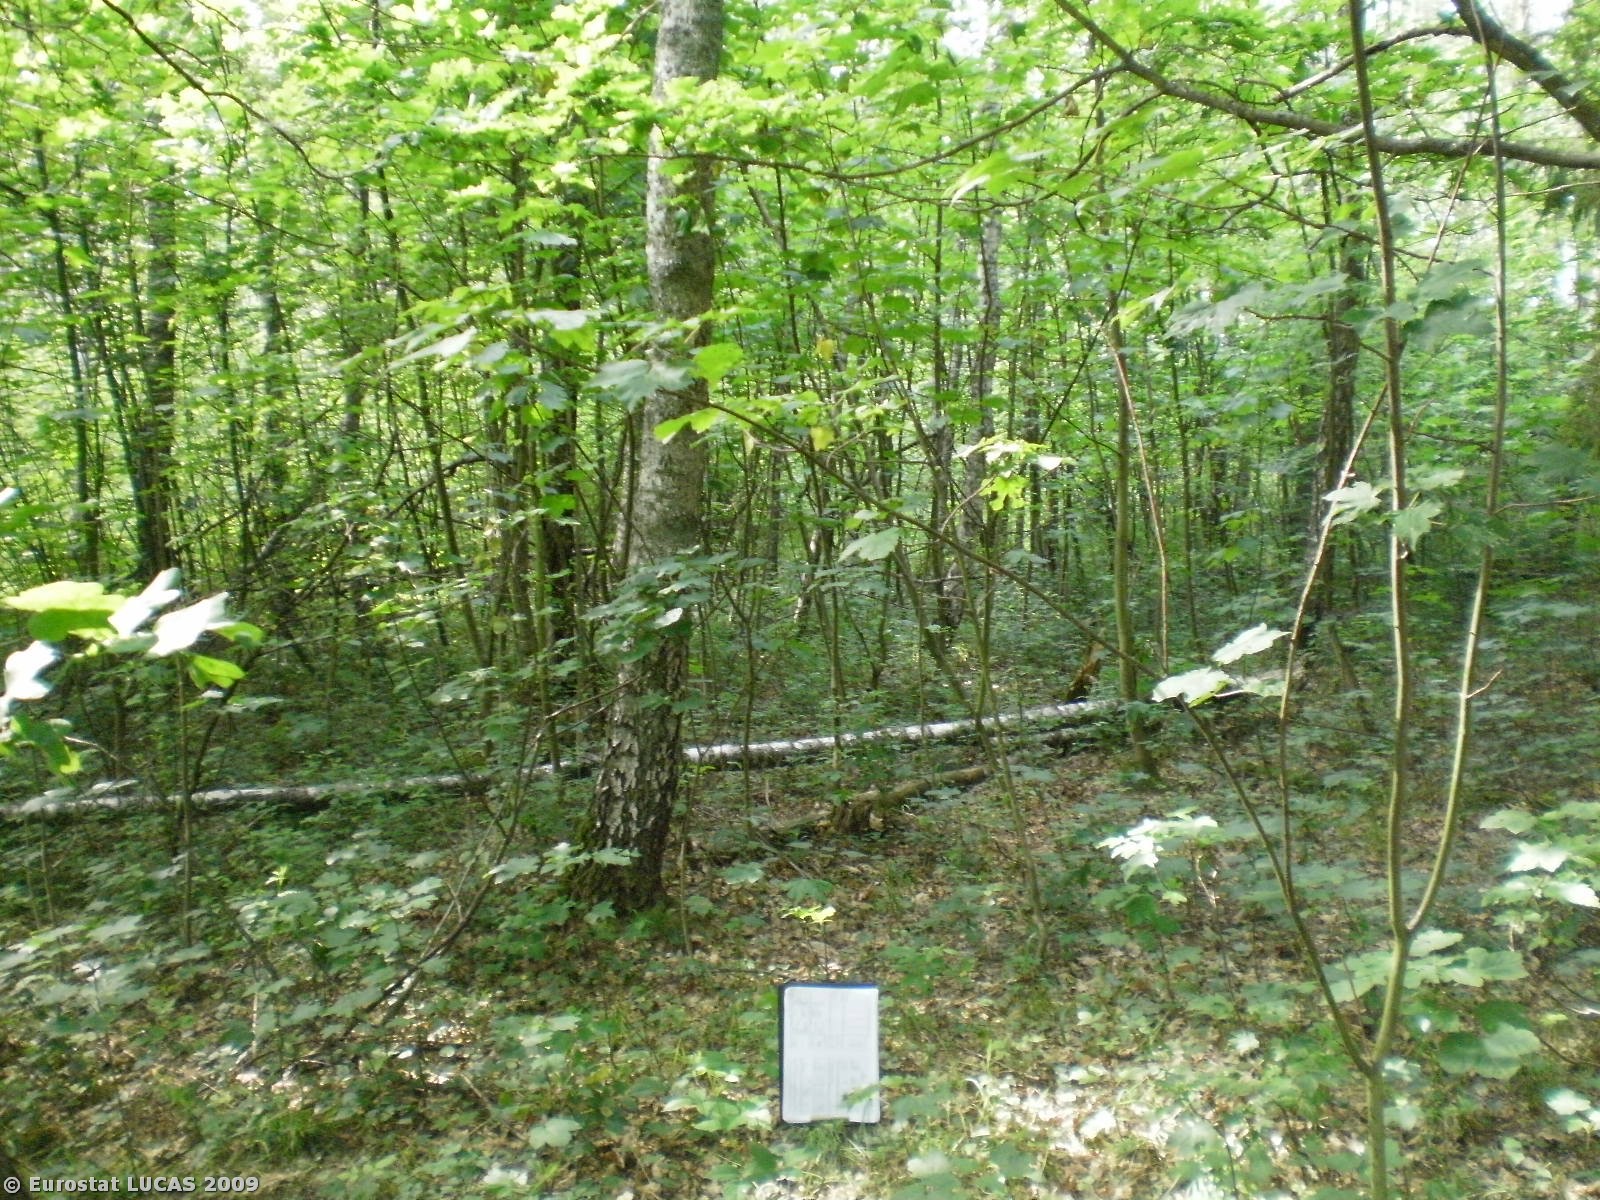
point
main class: Woodland
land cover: Mixed woodland
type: hemiboreal forest and nemoral coniferous forest and mixed broadleaved-coniferous forest
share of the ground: > 75 %
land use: Forestry
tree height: > 5 m
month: June
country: PL
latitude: 54.6788
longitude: 17.9067
